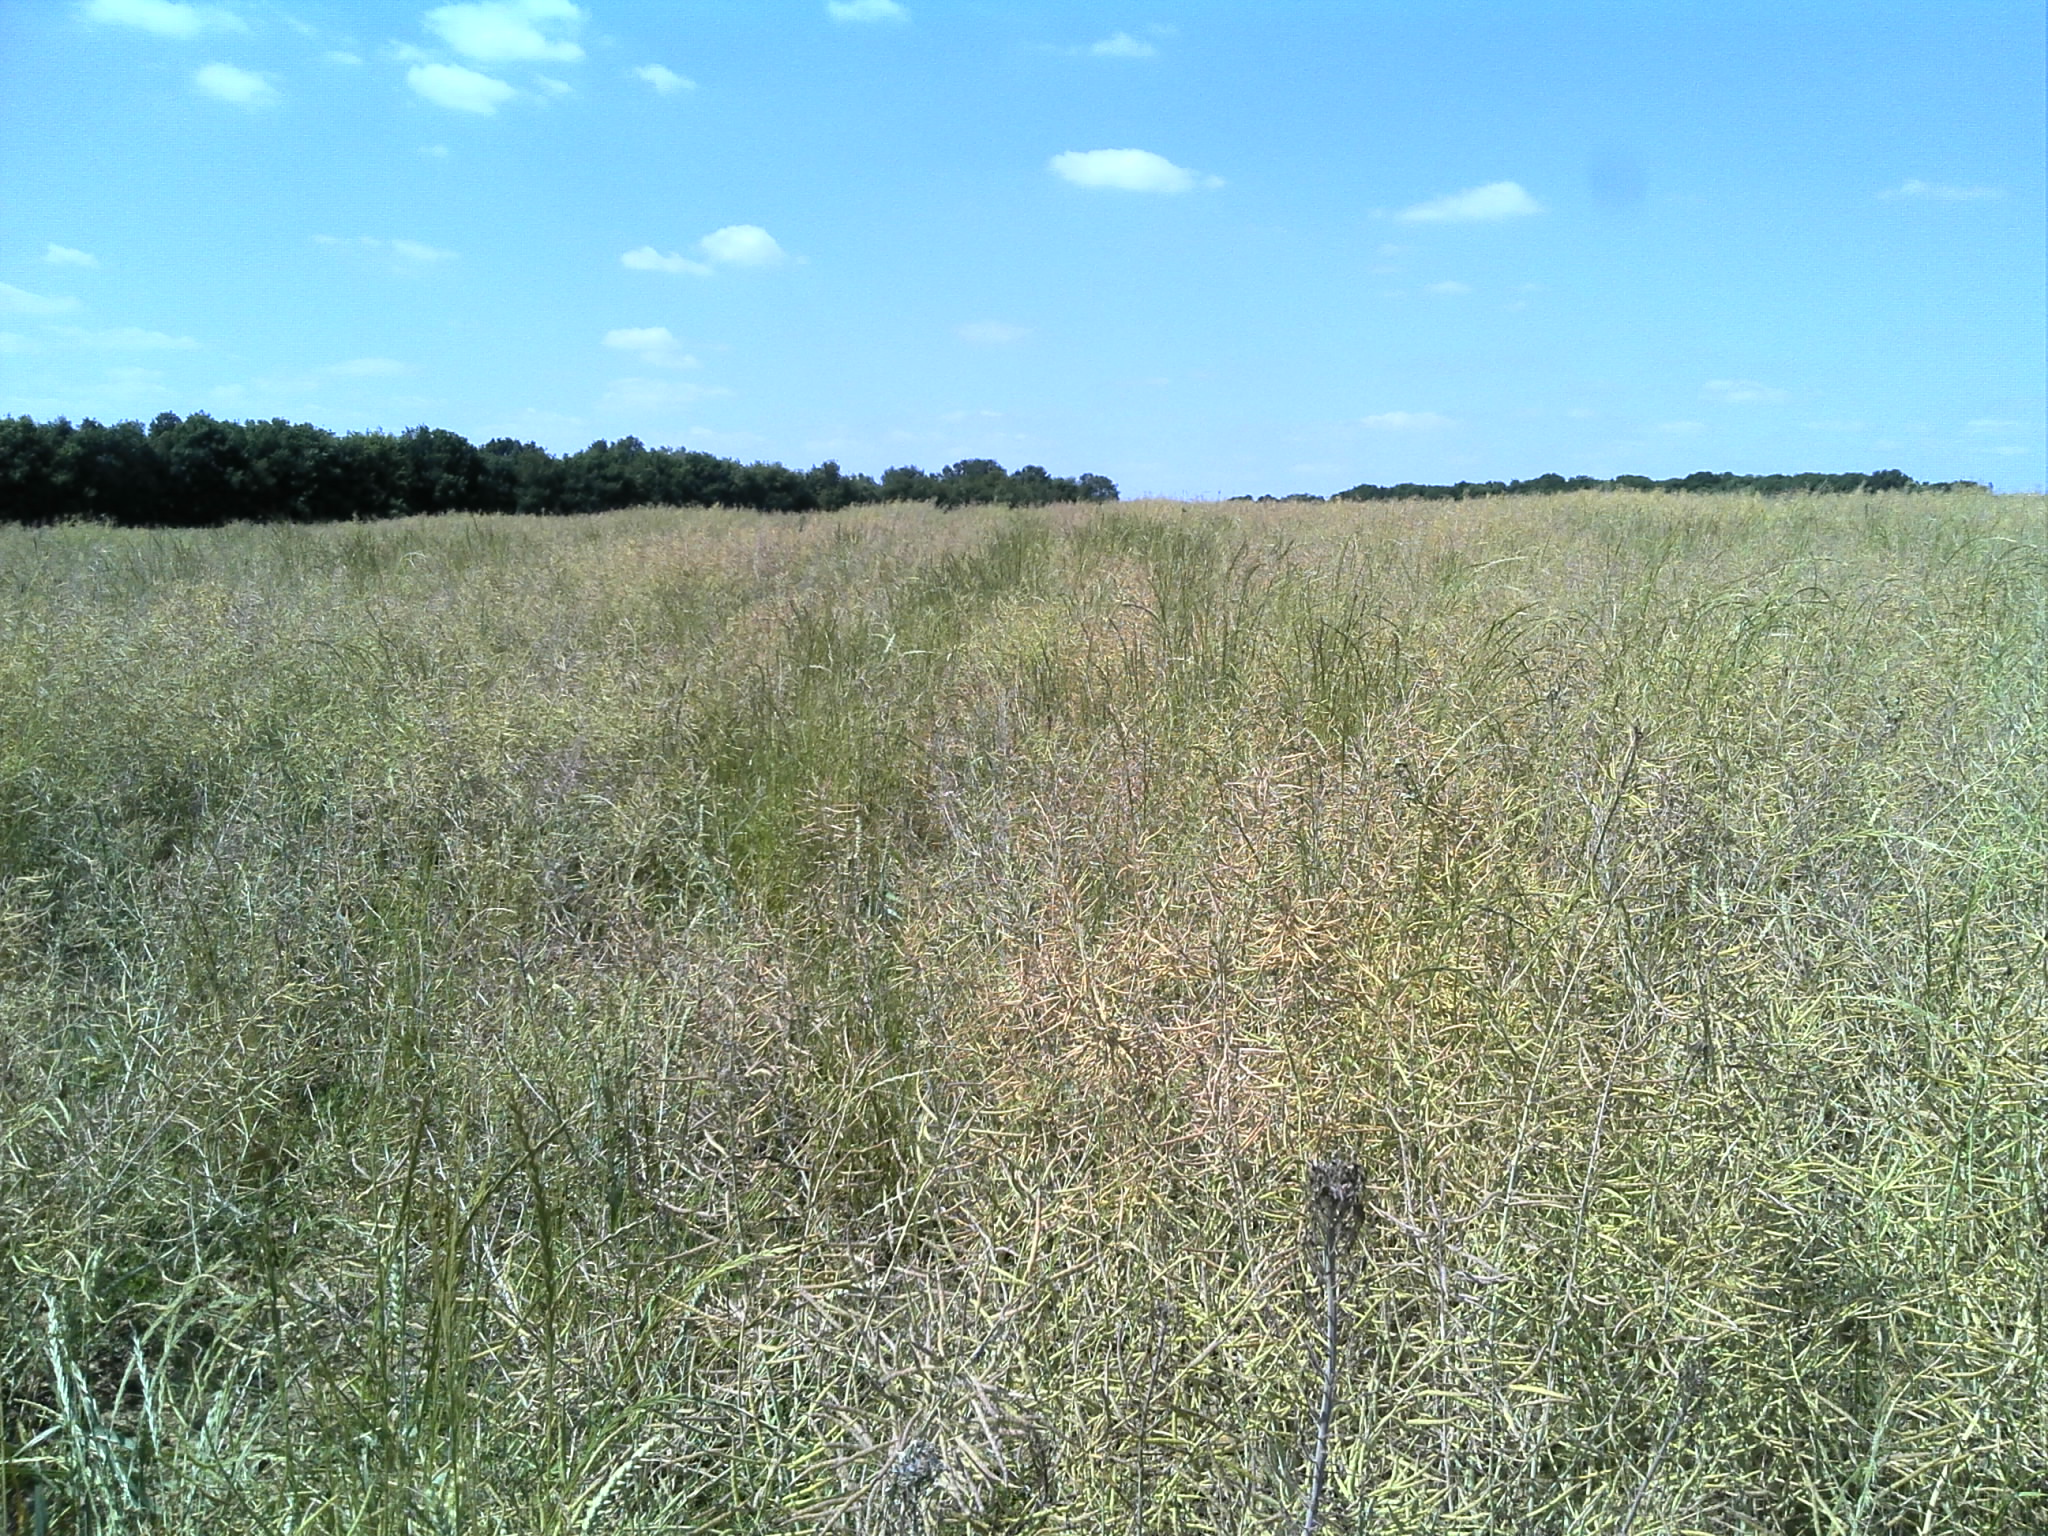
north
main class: Cropland
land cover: Rape and turnip rape
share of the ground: > 75 %
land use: Agriculture (excluding fallow land and kitchen gardens)
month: June
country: FR
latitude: 47.1493
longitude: 1.4545
